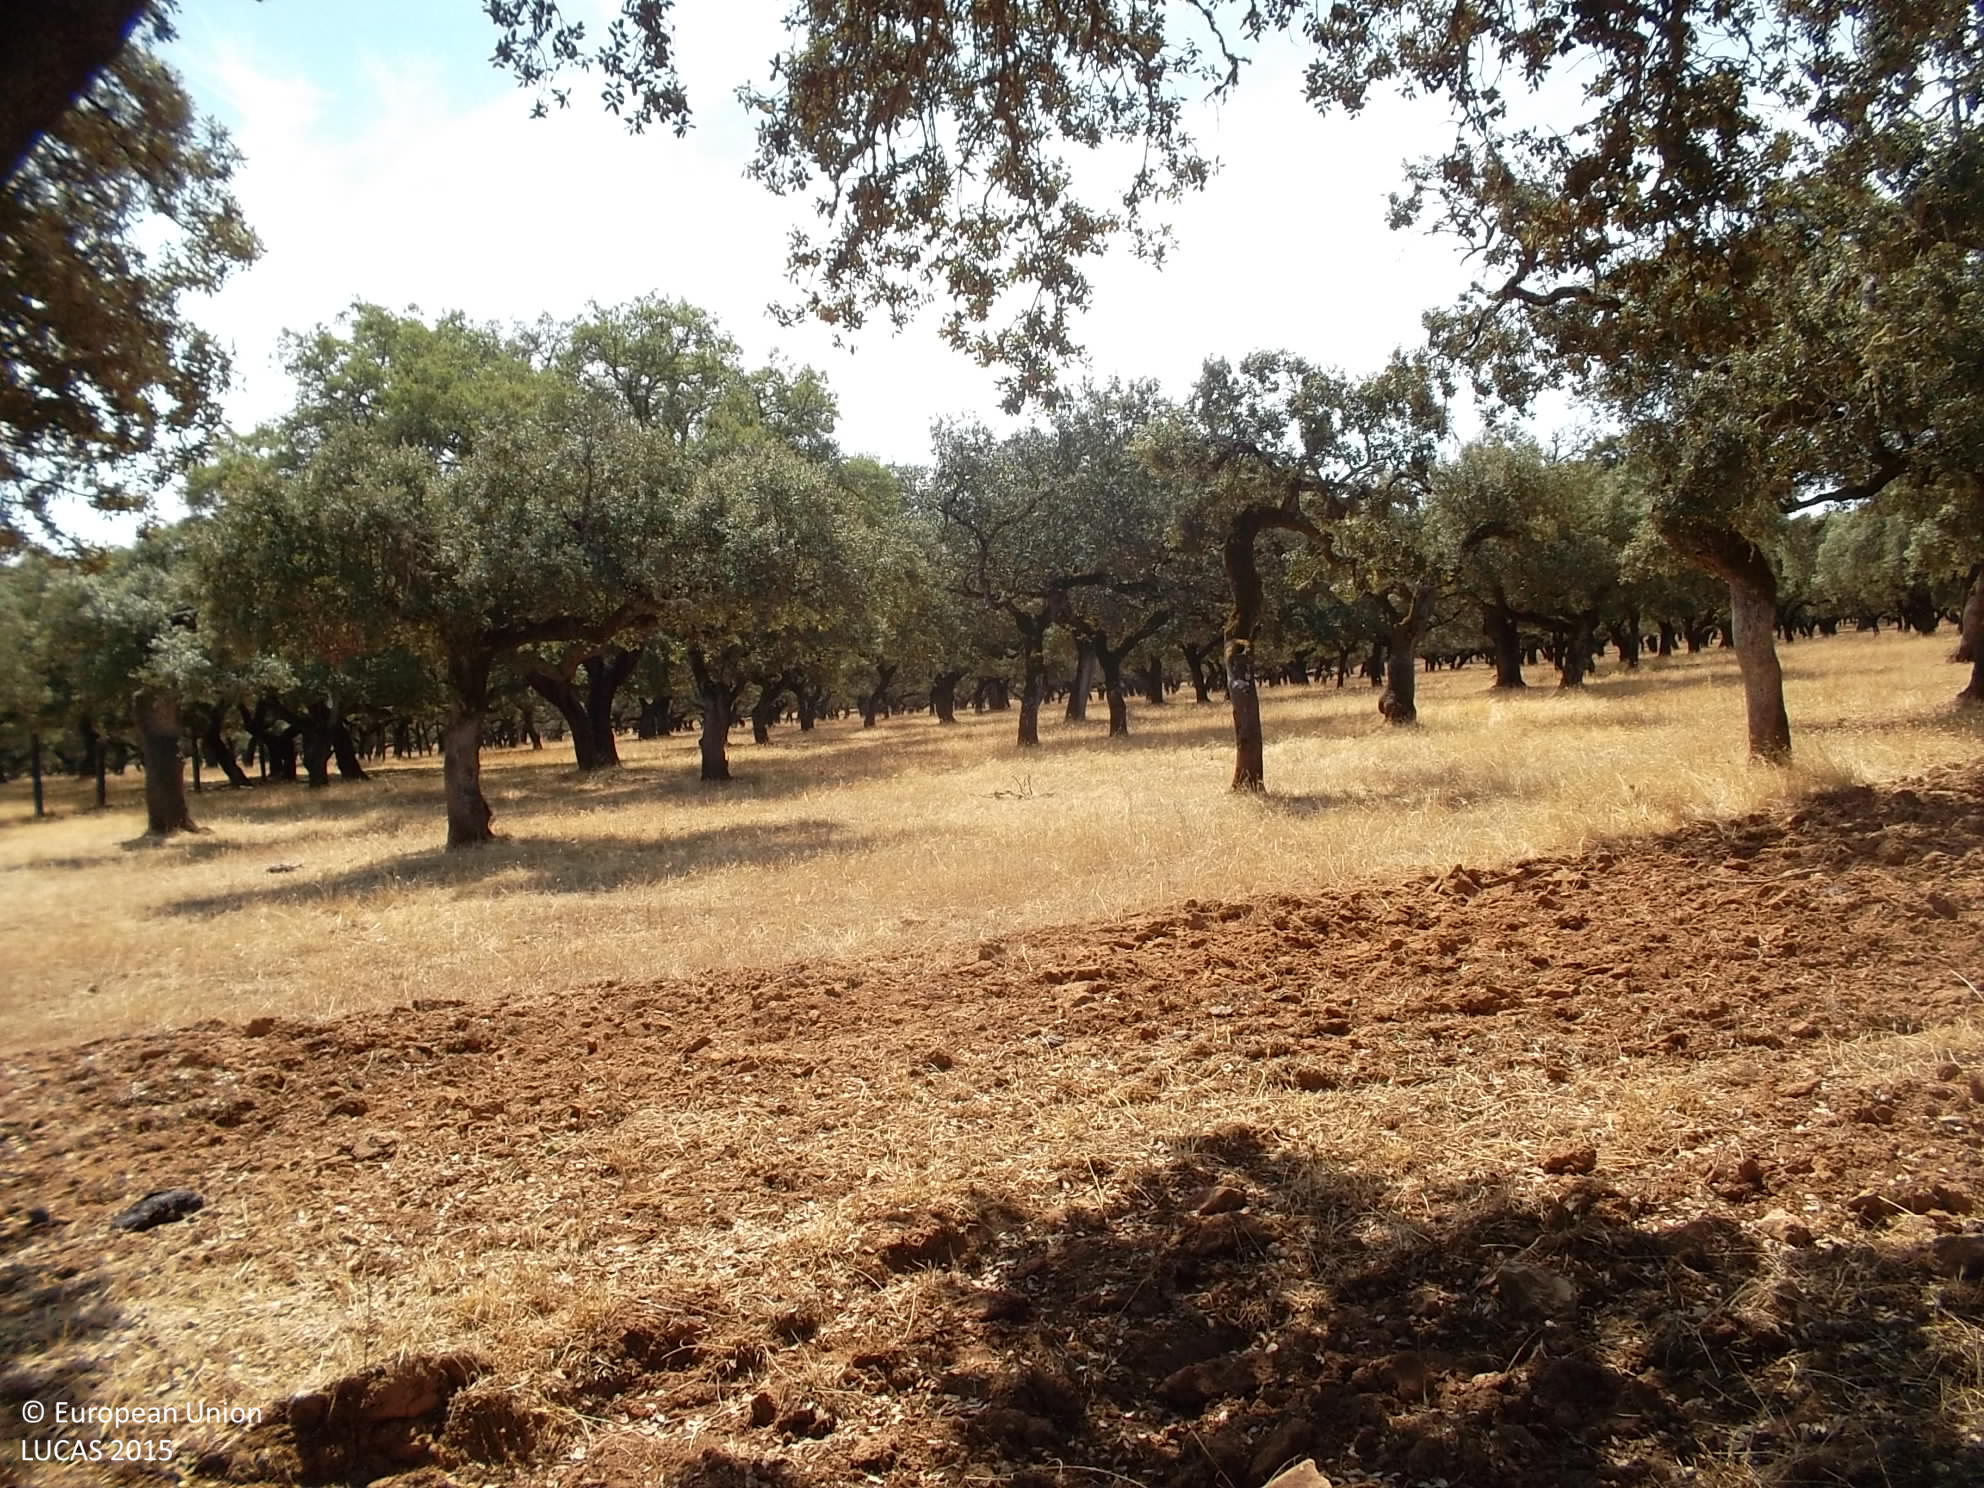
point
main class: Woodland
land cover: Broadleaved woodland
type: broadleaved evergreen forest
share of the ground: 50 - 75 %
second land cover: Grassland without tree/shrub cover
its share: > 75 %
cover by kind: broadleaved forest trees 50 %, herbaceous plants 50 %
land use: Forestry
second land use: Agriculture (excluding fallow land and kitchen gardens)
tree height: > 5 m
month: August
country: ES
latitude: 38.2074
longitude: -6.6444
